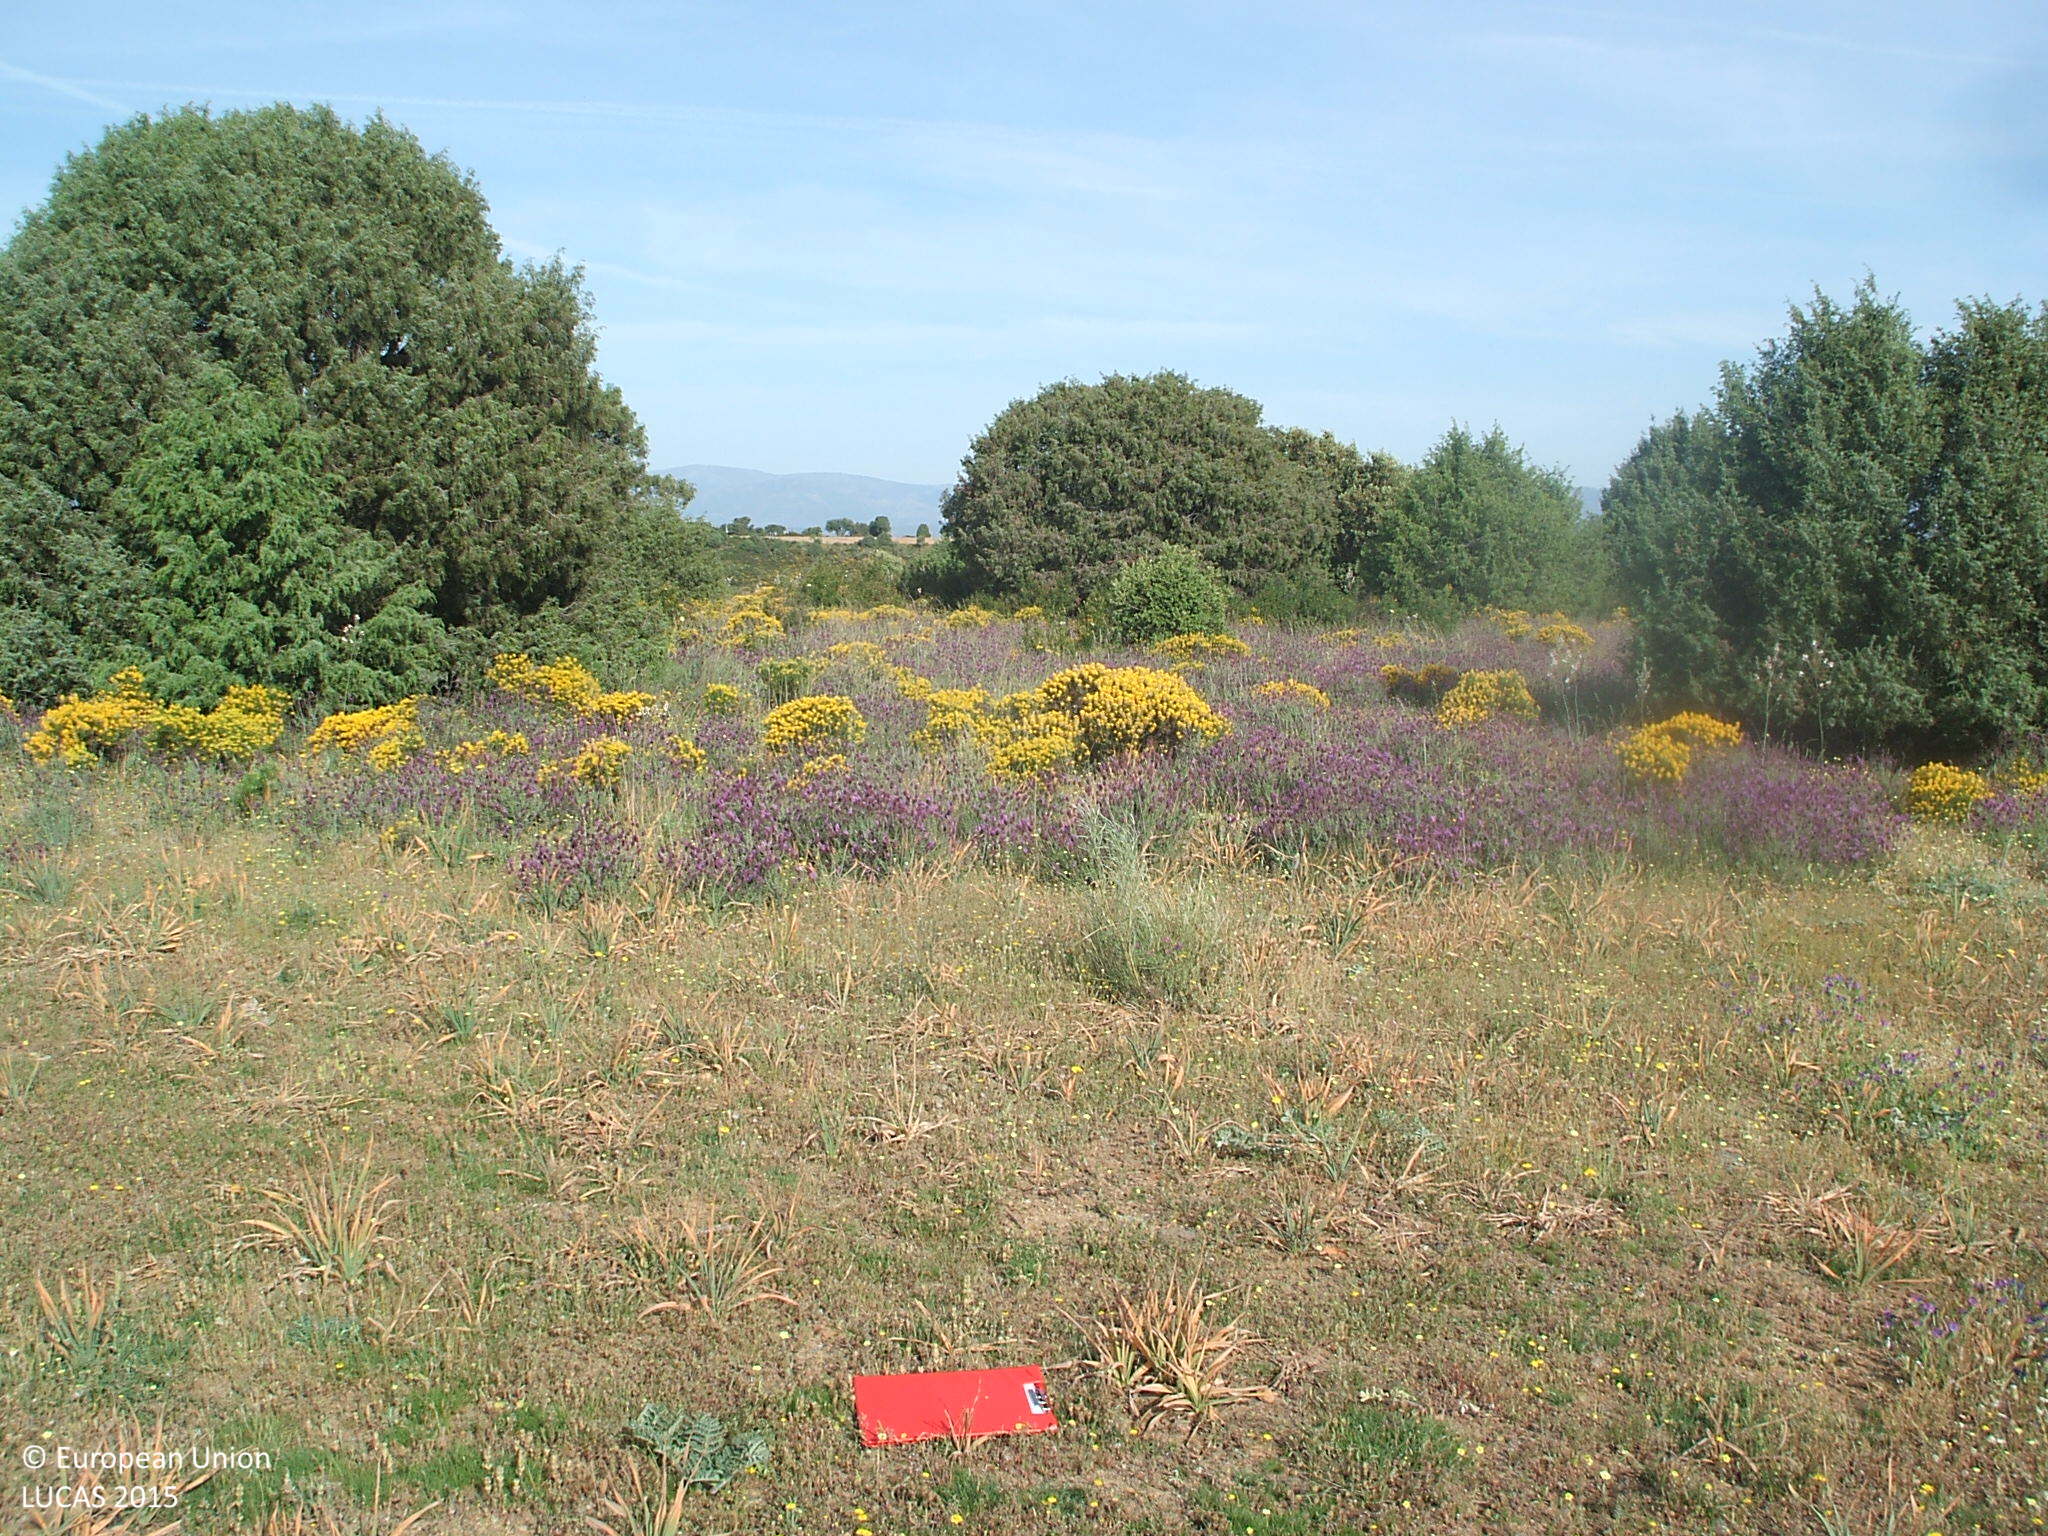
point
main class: Shrubland
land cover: Shrubland with sparse tree cover
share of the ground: 10 - 25 %
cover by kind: herbaceous plants 75 %, shrubs 20 %, broadleaved forest trees 5 %
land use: Semi-natural and natural areas not in use
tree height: > 5 m
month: May
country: ES
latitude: 40.7664
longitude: -3.4371
